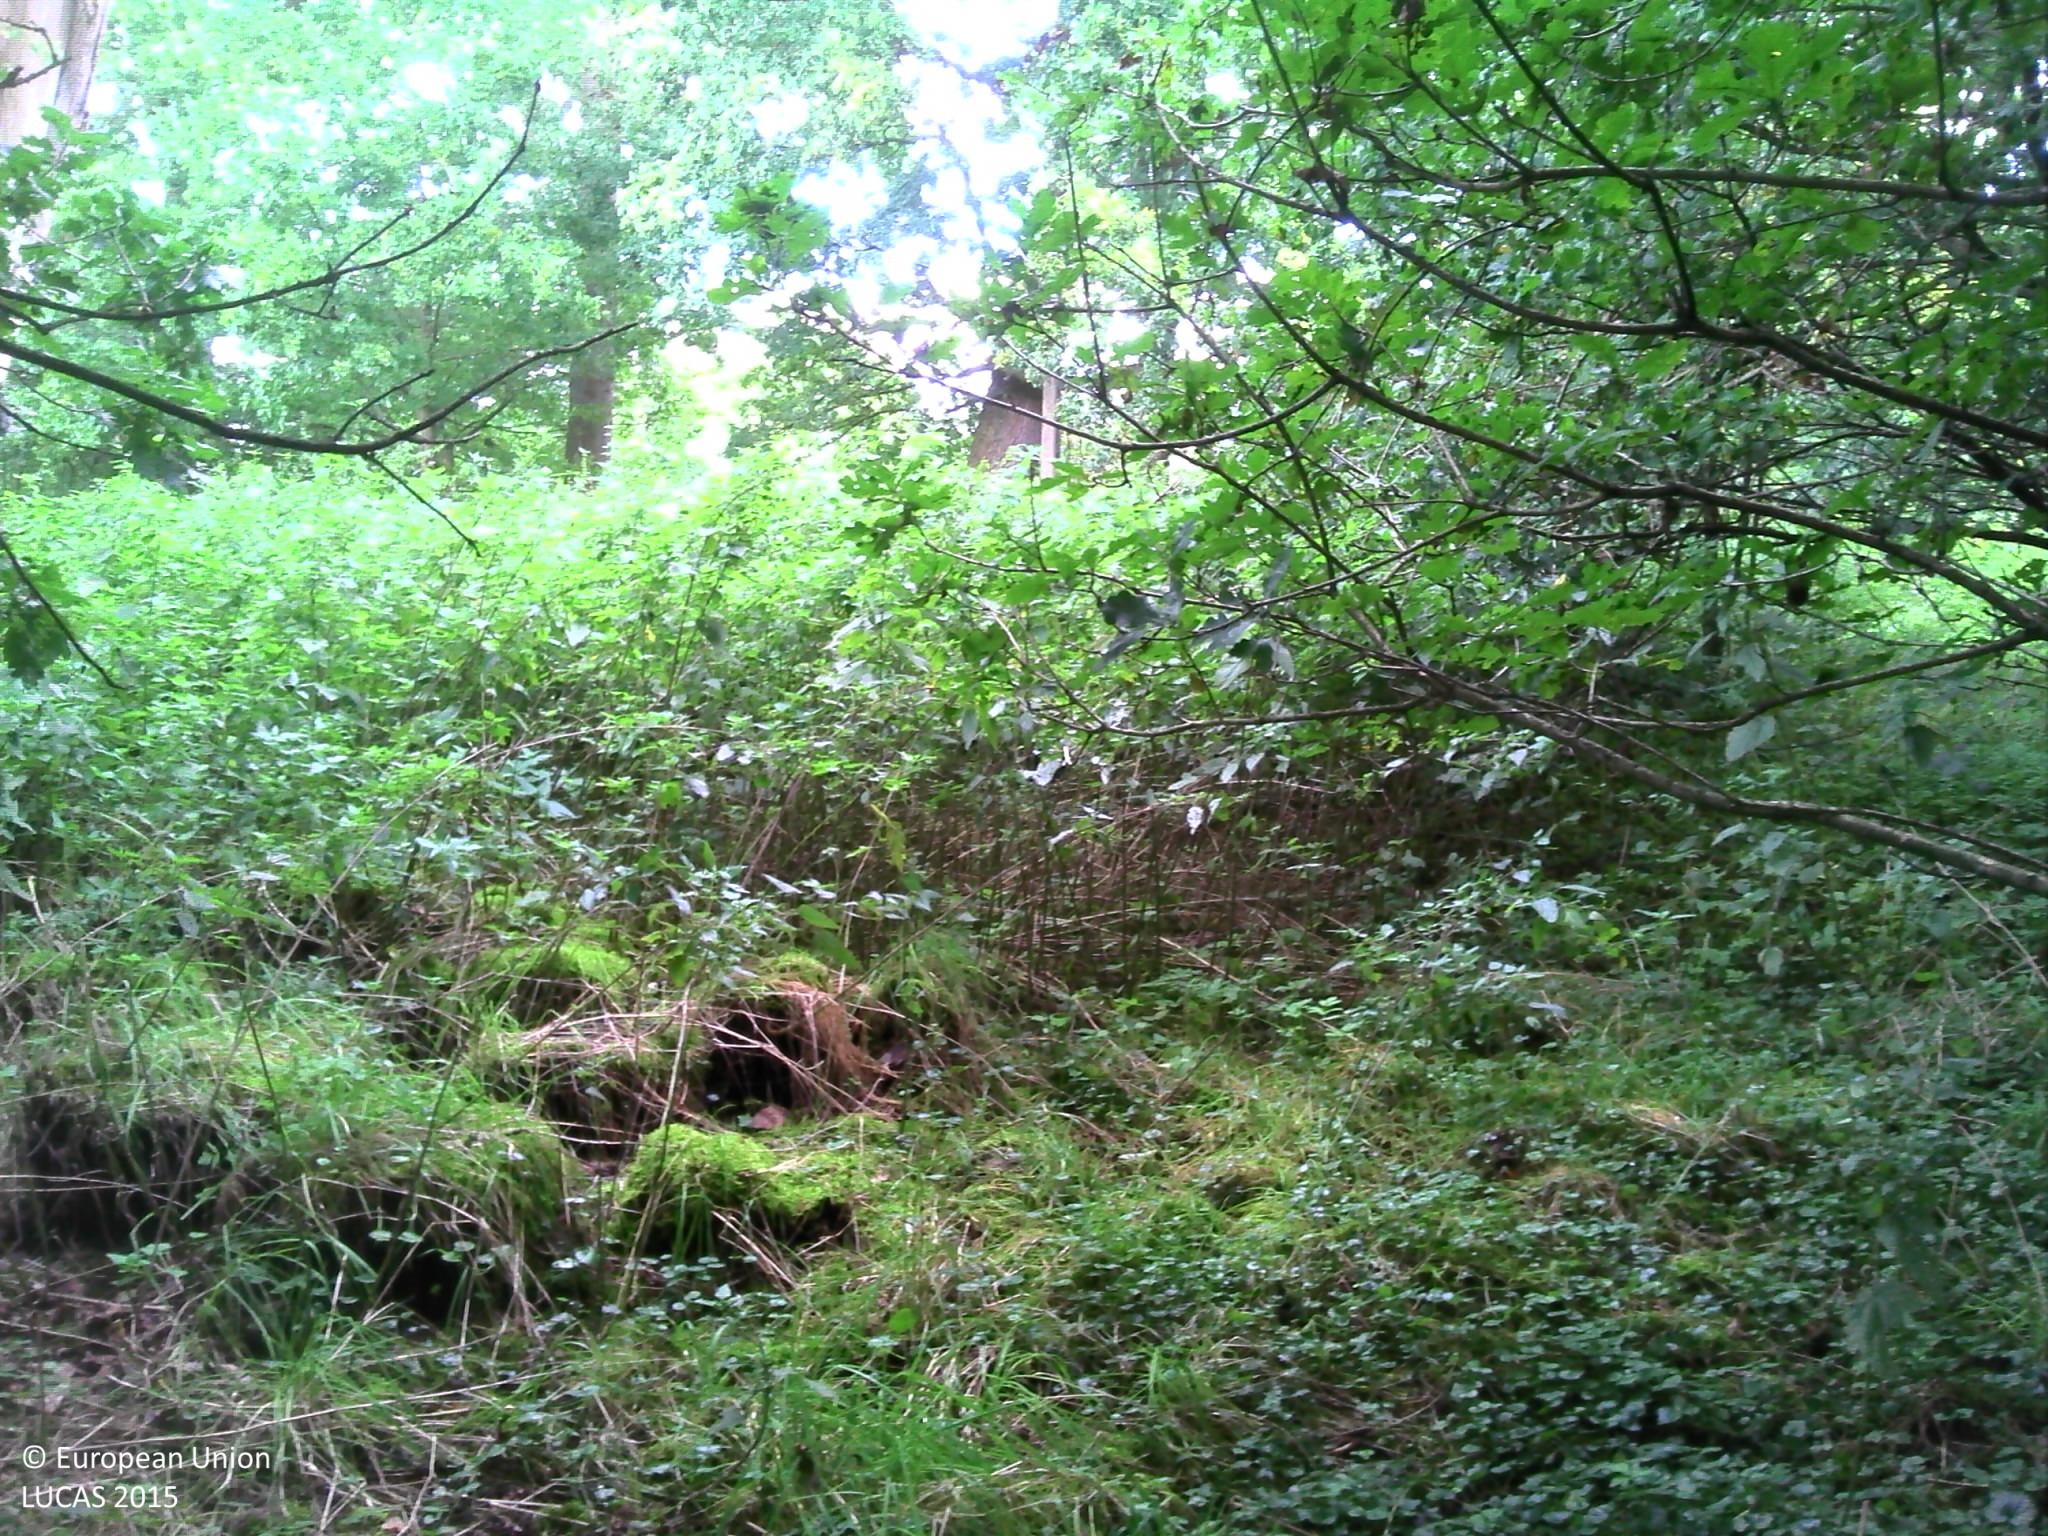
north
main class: Woodland
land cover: Broadleaved woodland
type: mesophytic deciduous forest
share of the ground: > 75 %
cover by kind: broadleaved forest trees 75 %, herbaceous plants 25 %
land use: Forestry
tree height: > 5 m
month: September
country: BE
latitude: 51.0330
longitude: 4.6773
